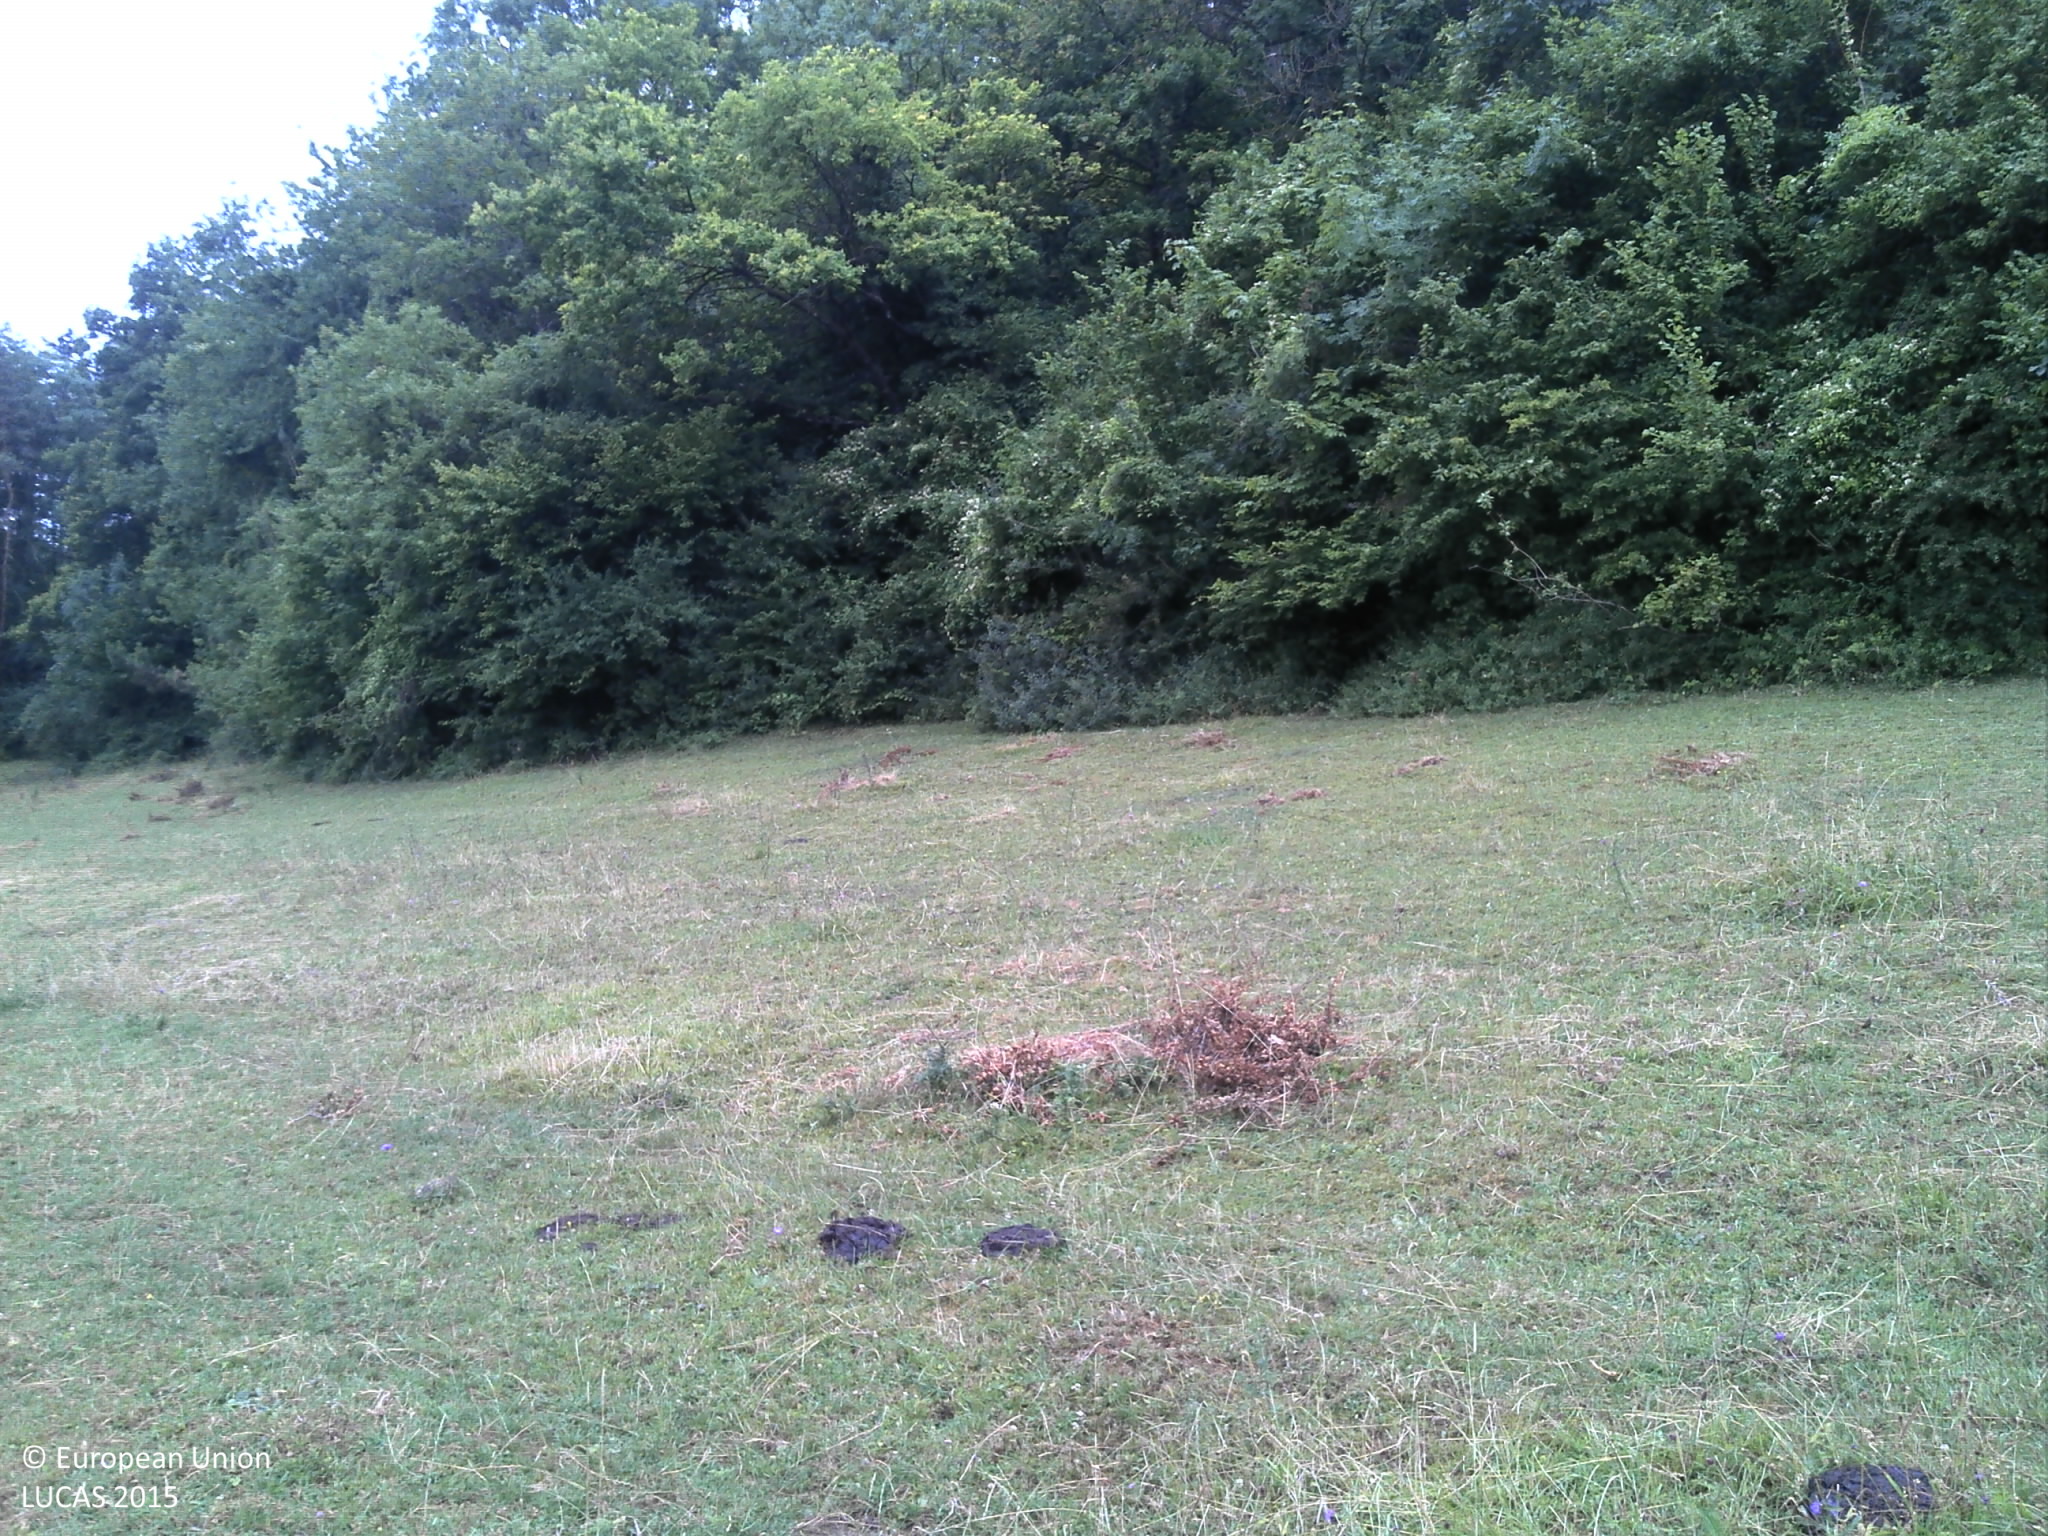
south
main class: Grassland
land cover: Grassland without tree/shrub cover
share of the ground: > 75 %
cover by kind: herbaceous plants 100 %
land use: Agriculture (excluding fallow land and kitchen gardens)
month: July
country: FR
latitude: 49.7498
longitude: 4.5975
